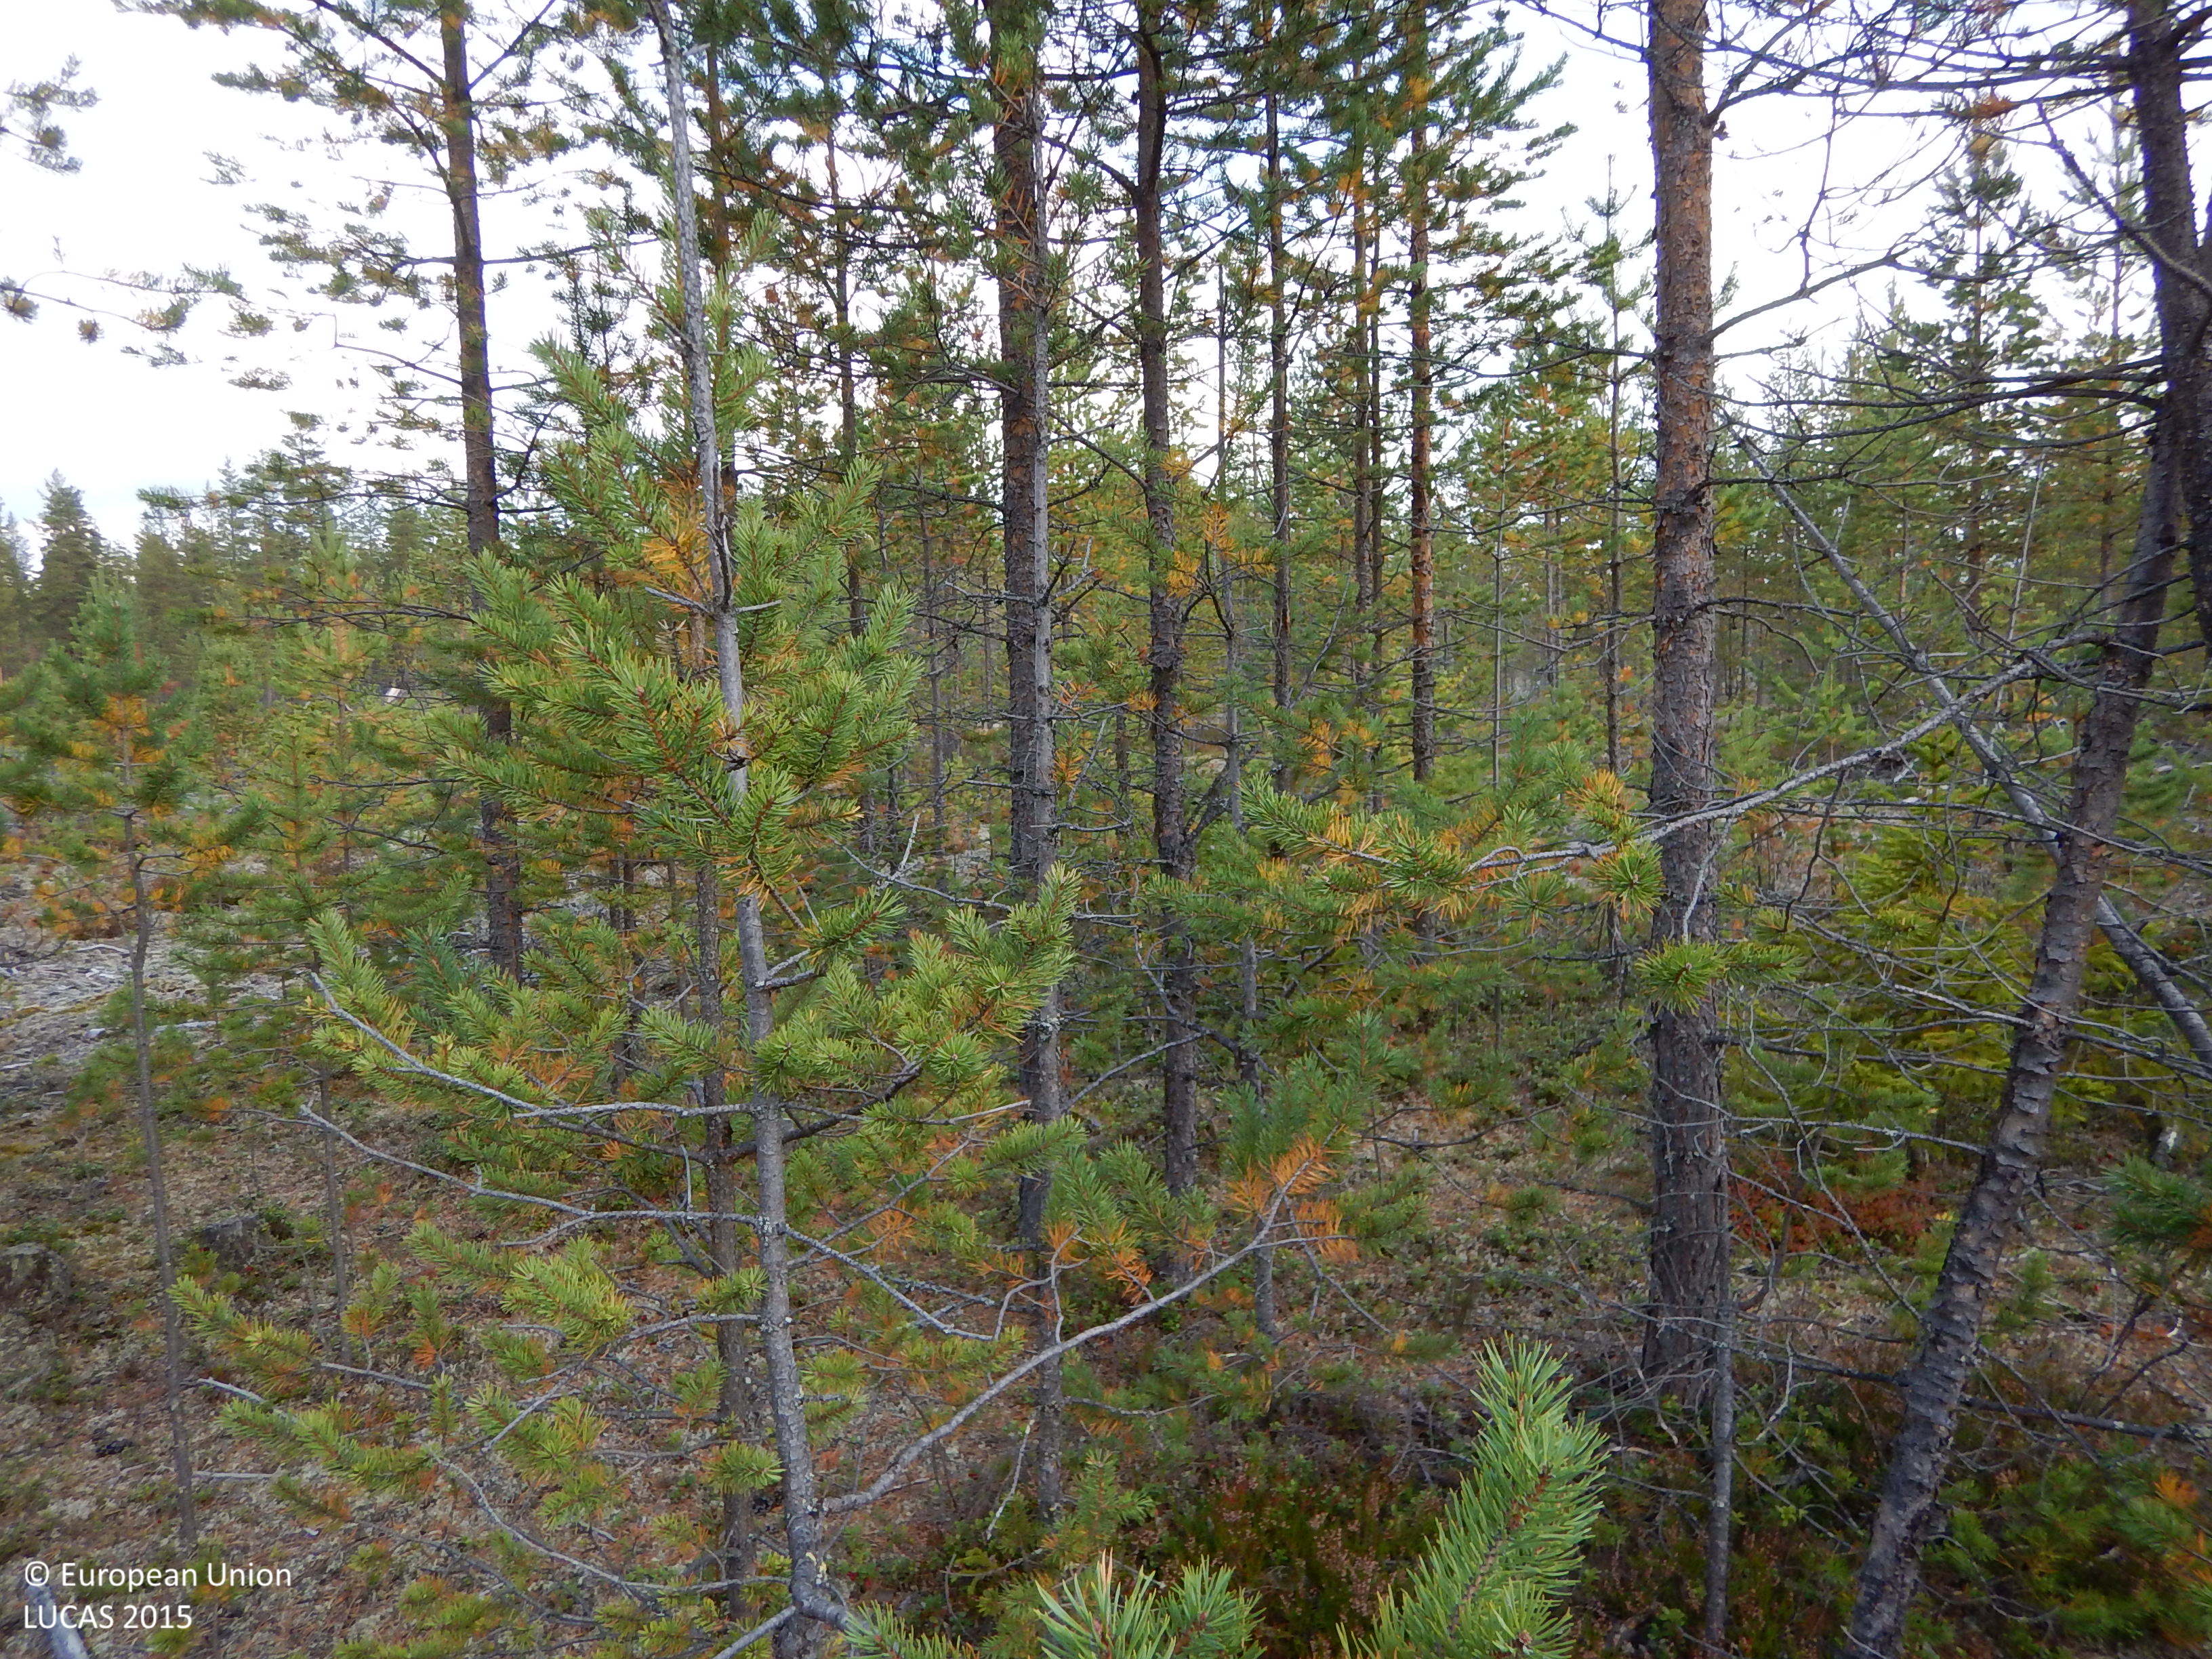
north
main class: Woodland
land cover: Pine dominated coniferous woodland
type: boreal forest
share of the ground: 25 - 50 %
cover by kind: coniferous forest trees 40 %, lichens and mosses 20 %, shrubs 15 %, herbaceous plants 10 %, broadleaved forest trees 5 %, consolidated bare surface 5 %, unconsolidated bare surface 5 %
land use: Forestry
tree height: < 5 m
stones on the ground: < 10 %
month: September
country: SE
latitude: 64.8355
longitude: 20.1944
